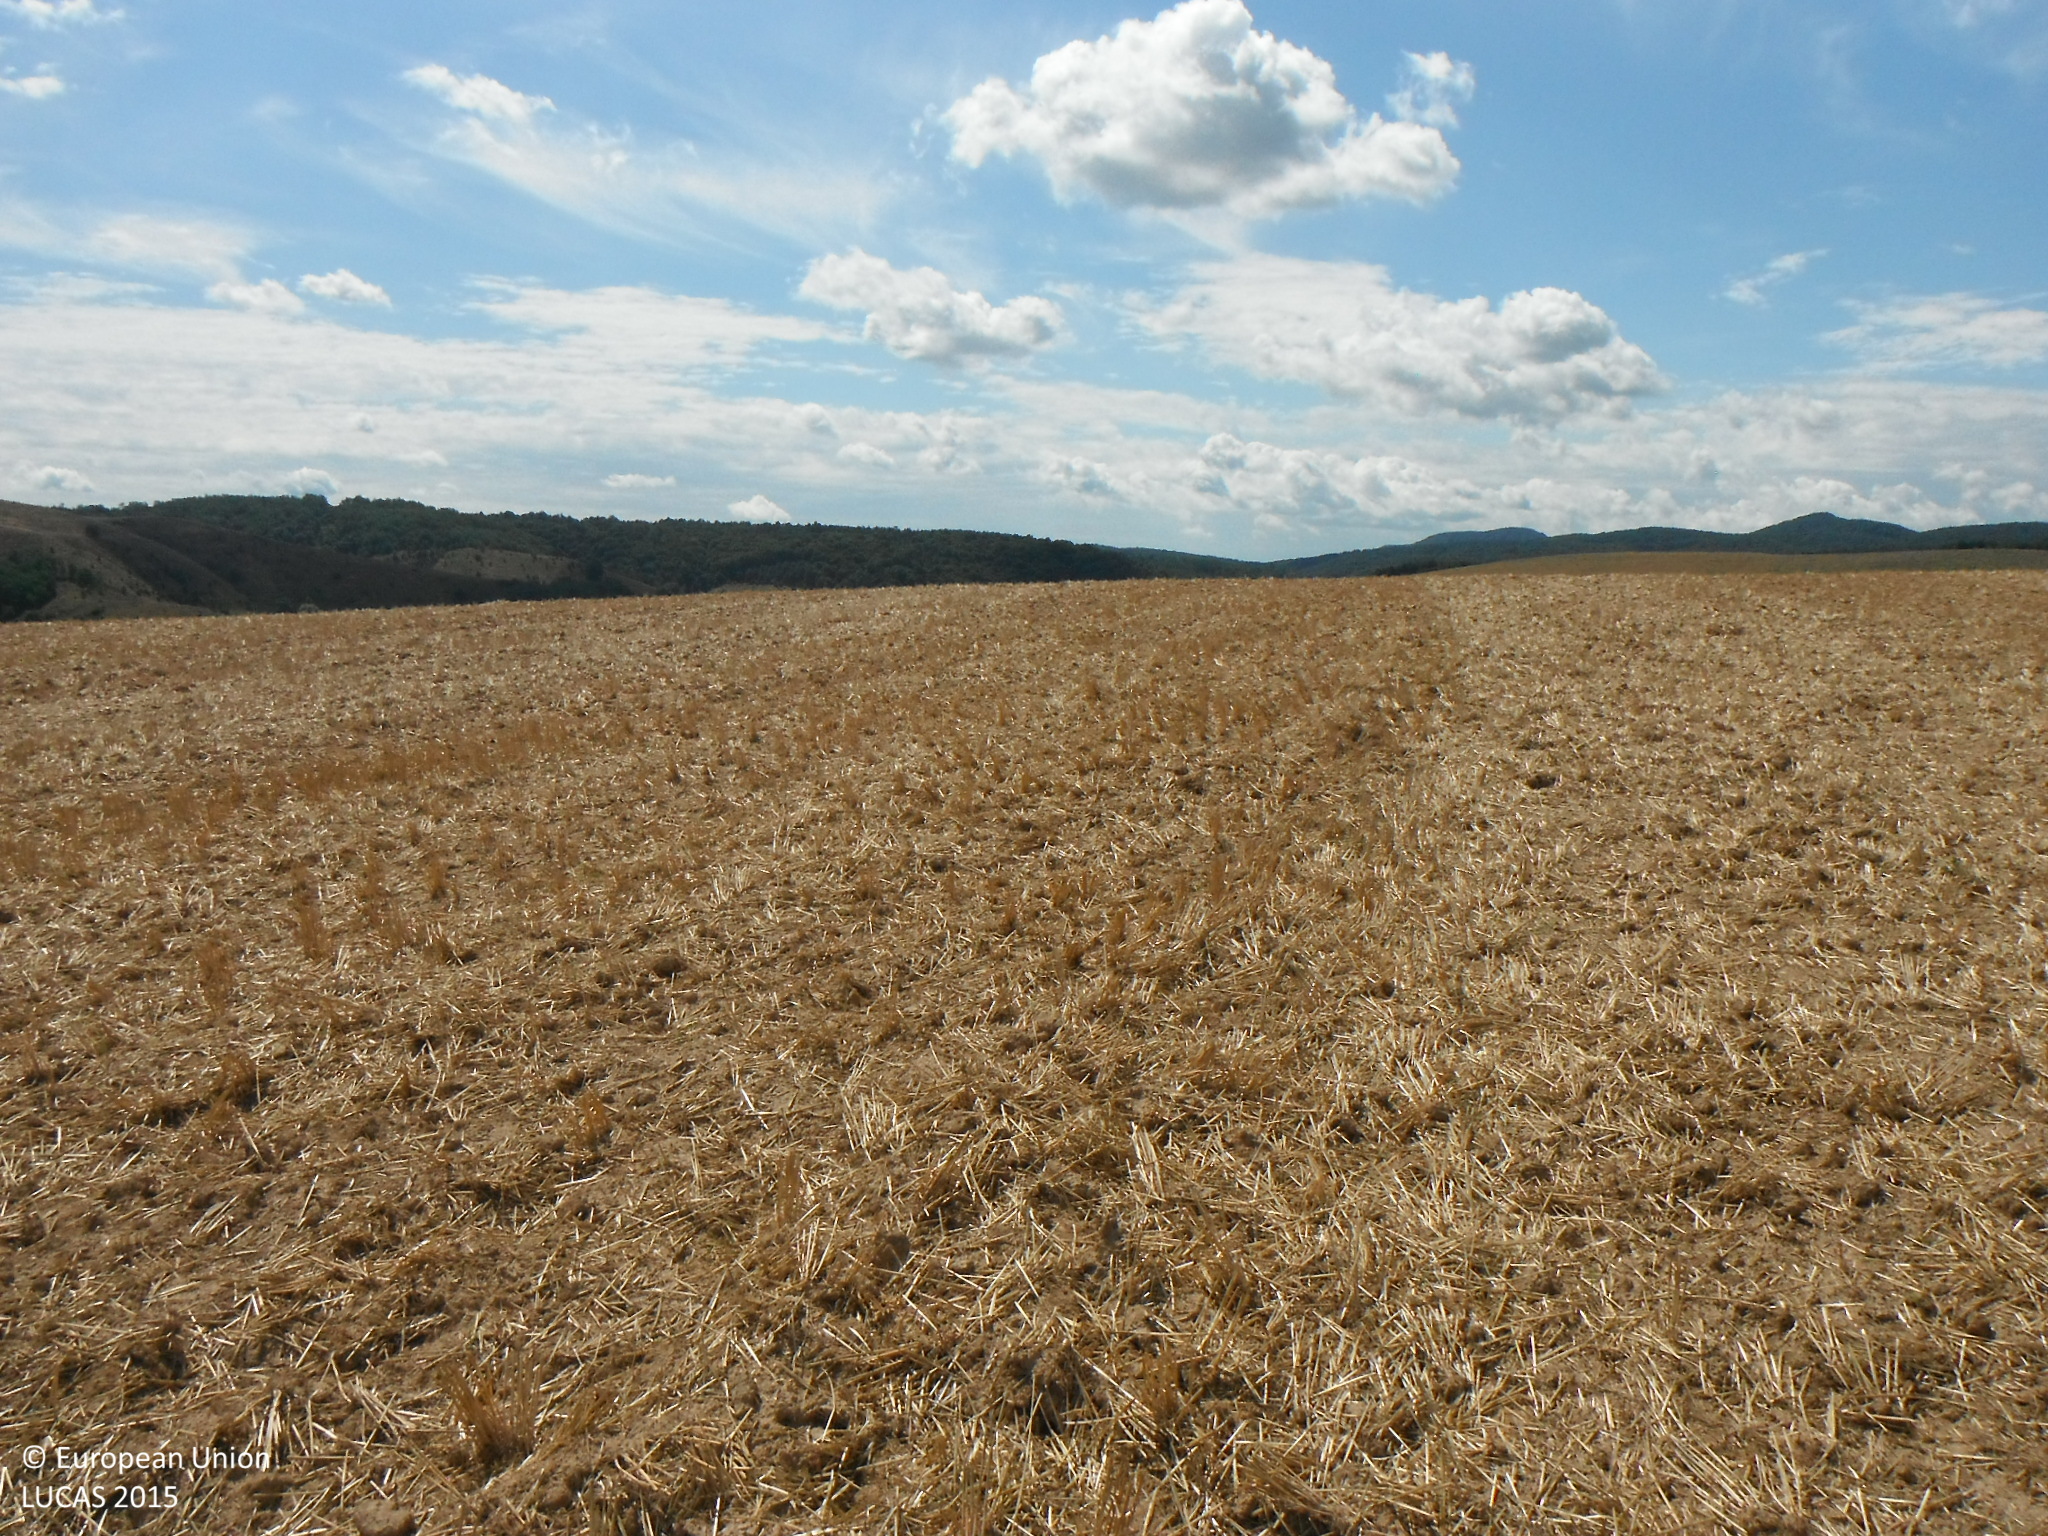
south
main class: Cropland
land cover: Common wheat
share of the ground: > 75 %
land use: Agriculture (excluding fallow land and kitchen gardens)
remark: Harvested field
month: July
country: SK
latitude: 48.2920
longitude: 20.0168
